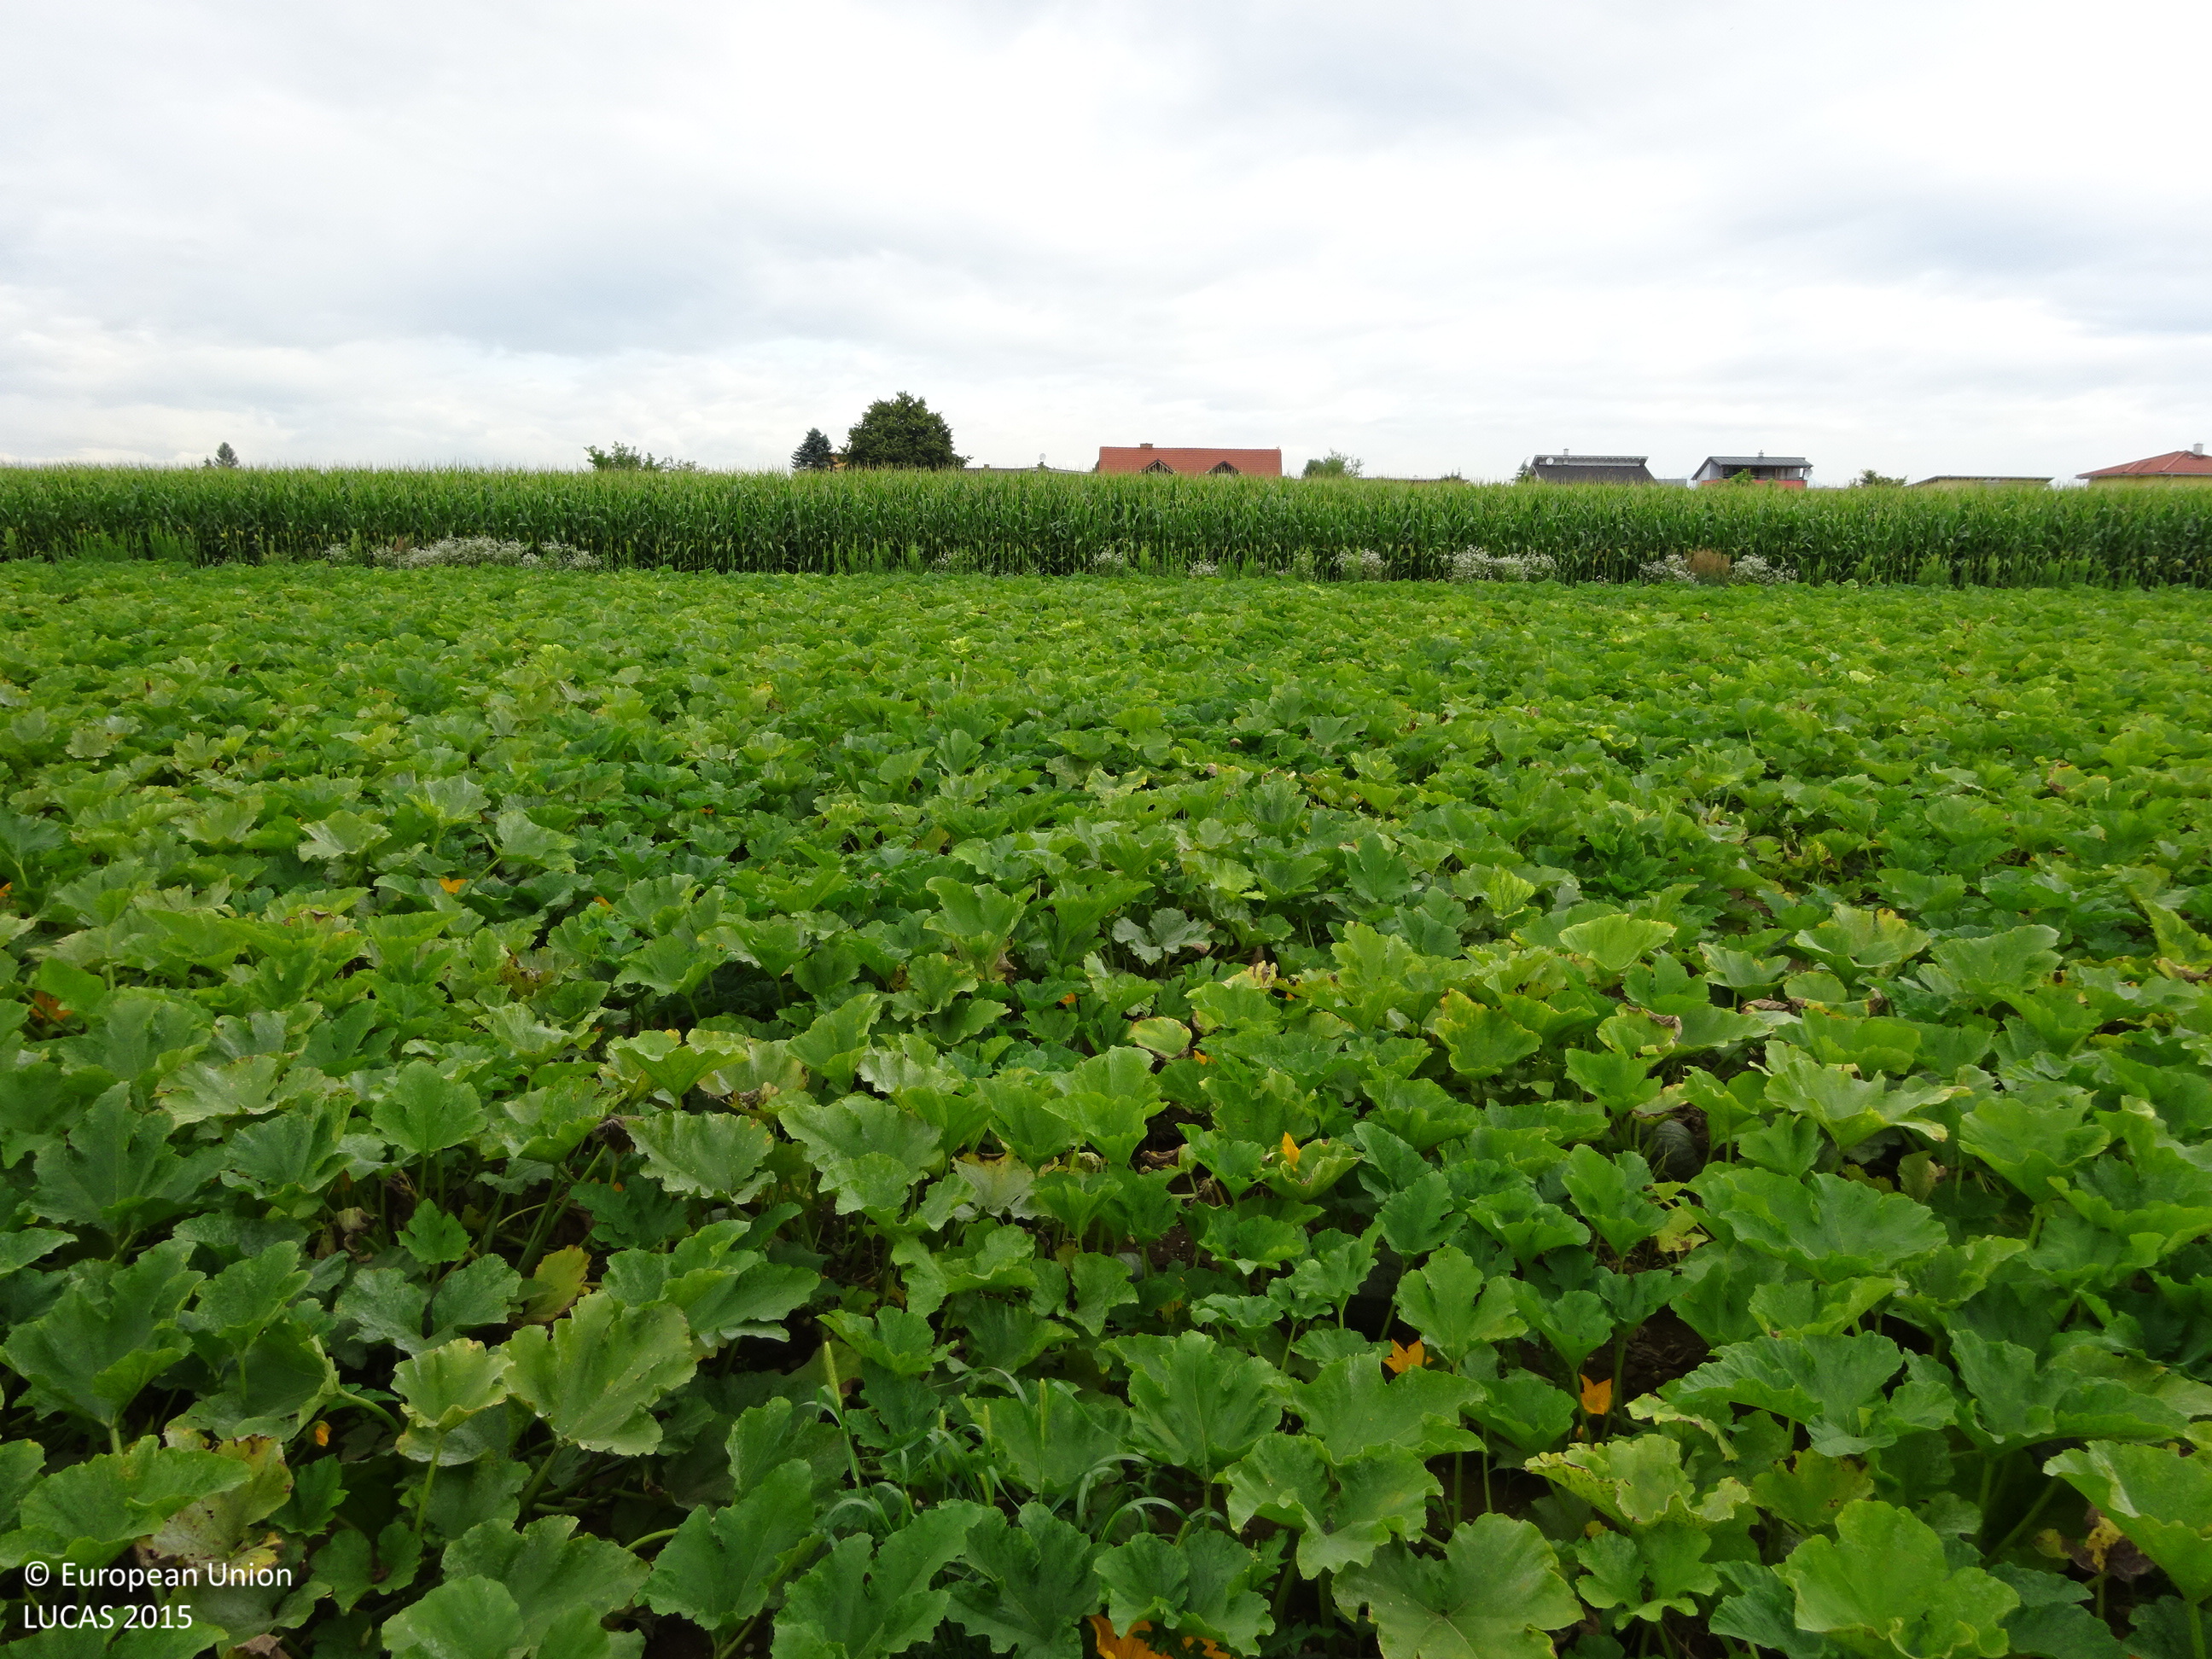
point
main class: Cropland
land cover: Other fibre and oleaginous crops
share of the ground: > 75 %
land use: Agriculture (excluding fallow land and kitchen gardens)
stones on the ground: < 10 %
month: July
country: AT
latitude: 46.9508
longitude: 15.4787
